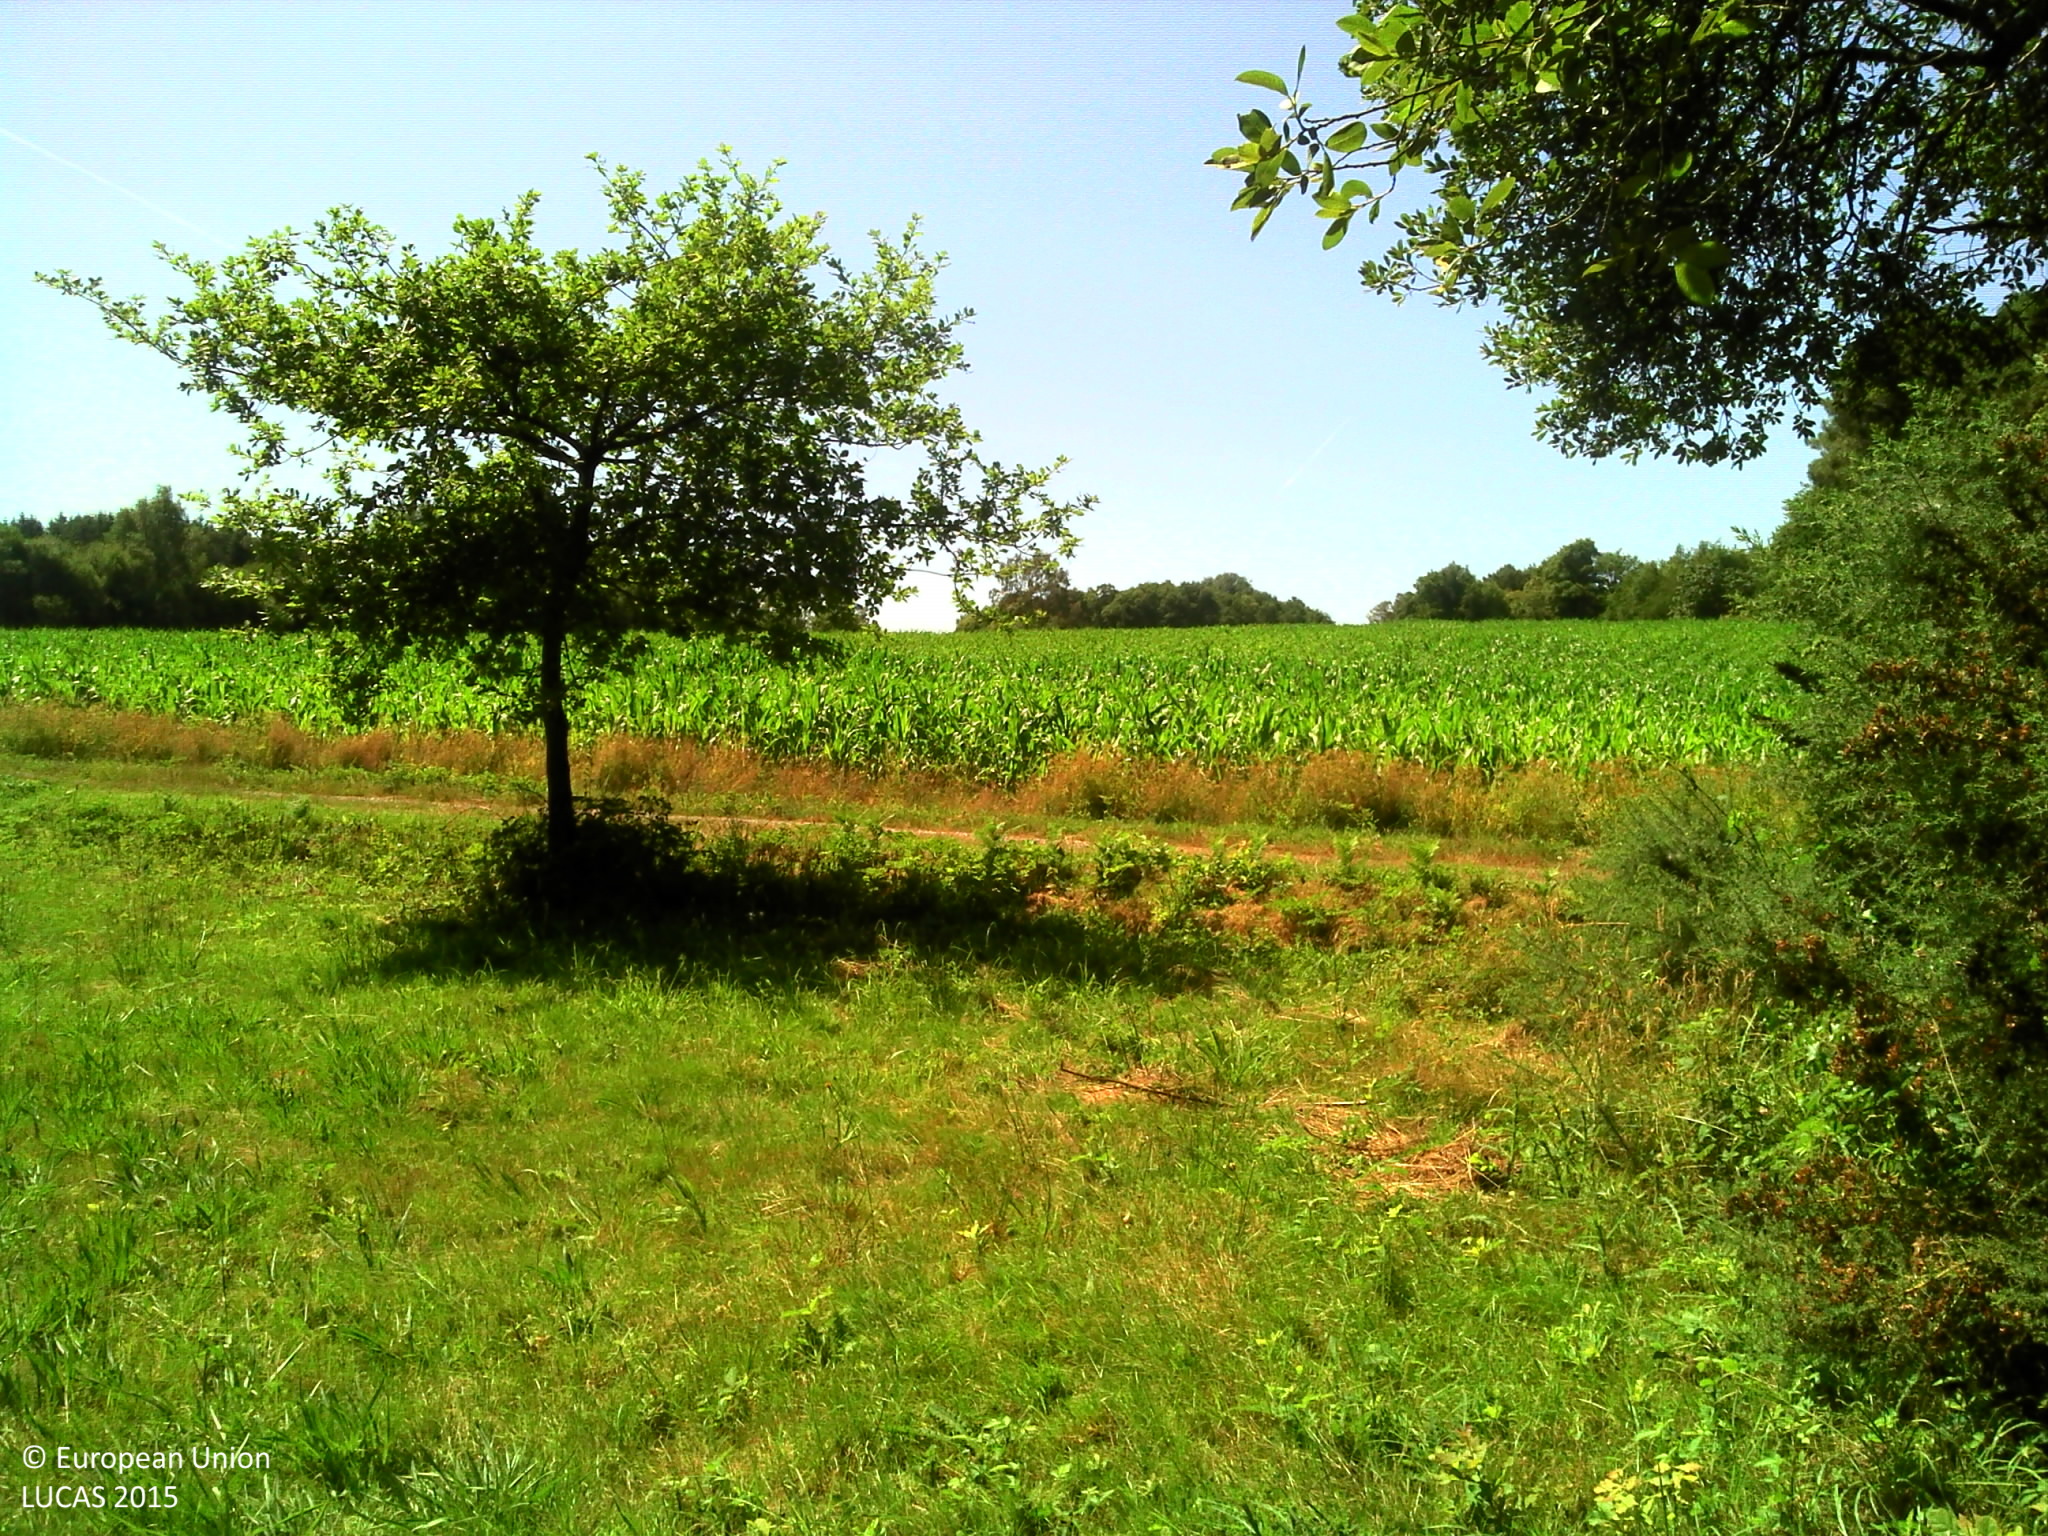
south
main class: Grassland
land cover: Grassland without tree/shrub cover
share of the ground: > 75 %
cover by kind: herbaceous plants 100 %
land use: Agriculture (excluding fallow land and kitchen gardens)
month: July
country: FR
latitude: 47.7250
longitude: -2.0368
